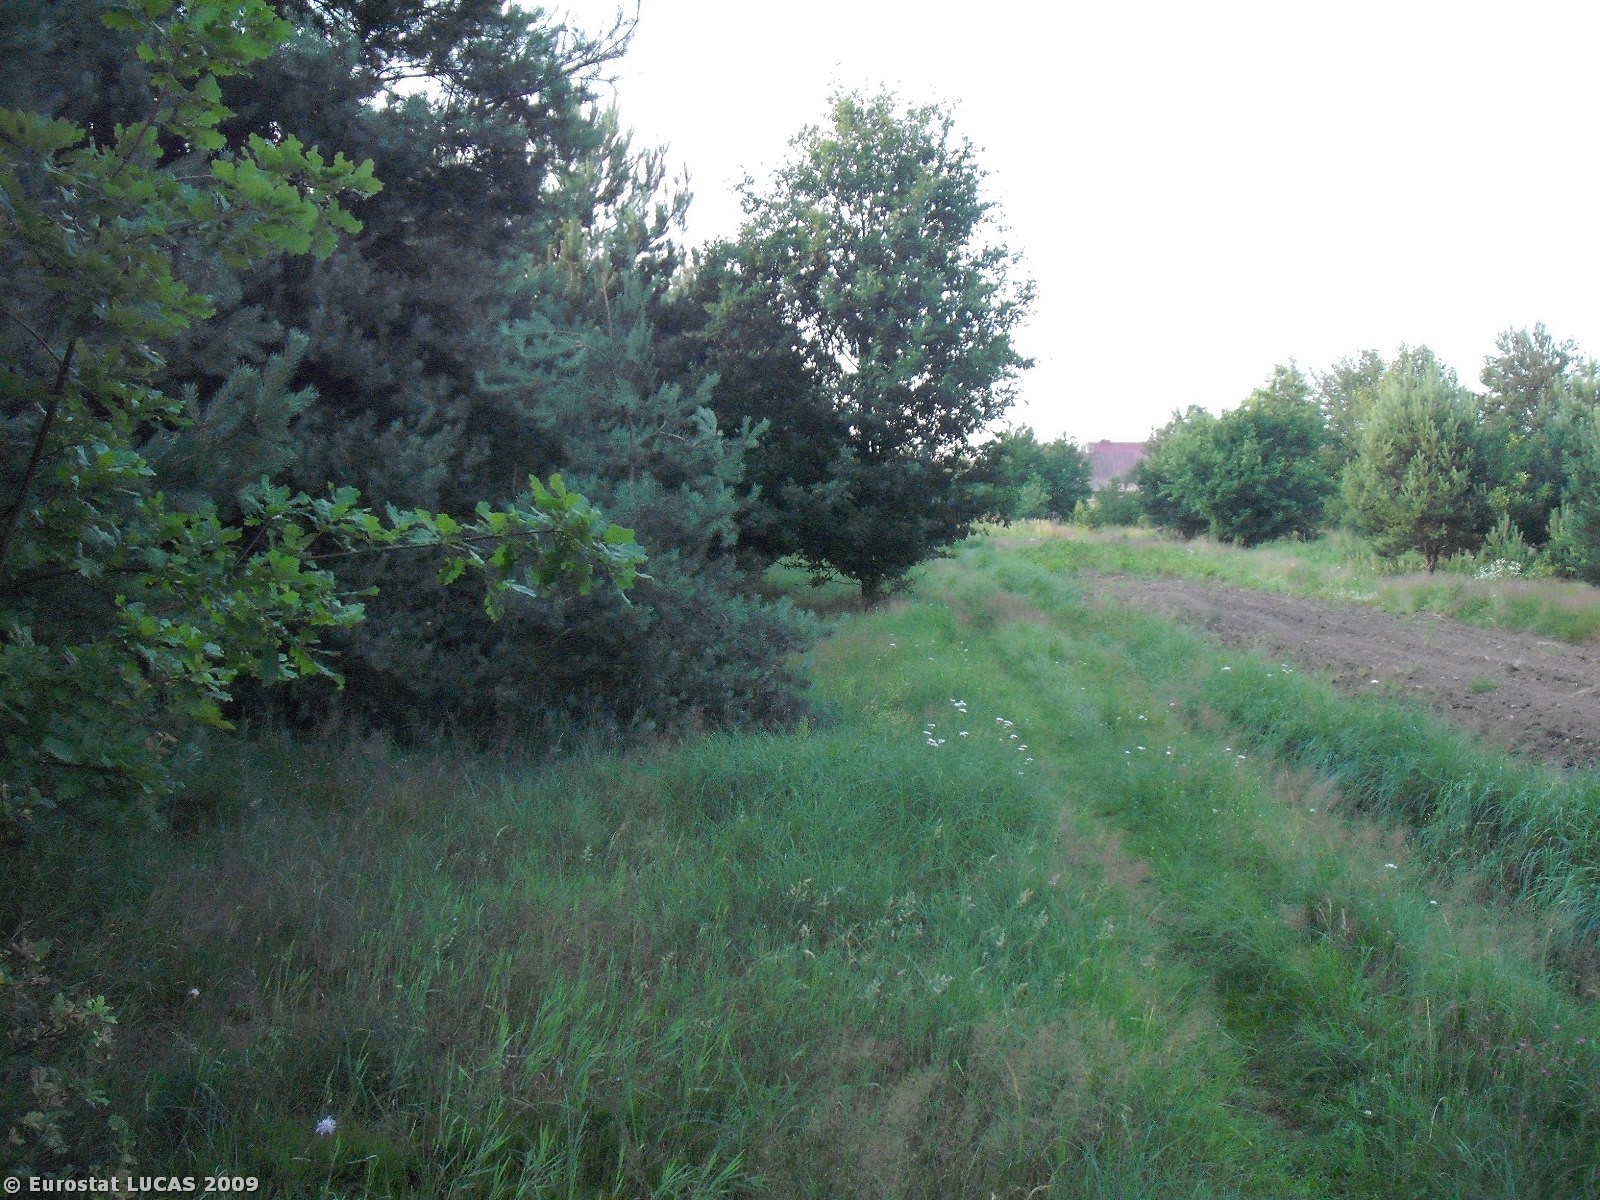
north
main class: Grassland
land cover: Grassland without tree/shrub cover
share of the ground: > 75 %
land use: Agriculture (excluding fallow land and kitchen gardens)
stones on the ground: < 10 %
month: July
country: PL
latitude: 51.0475
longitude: 20.8116
